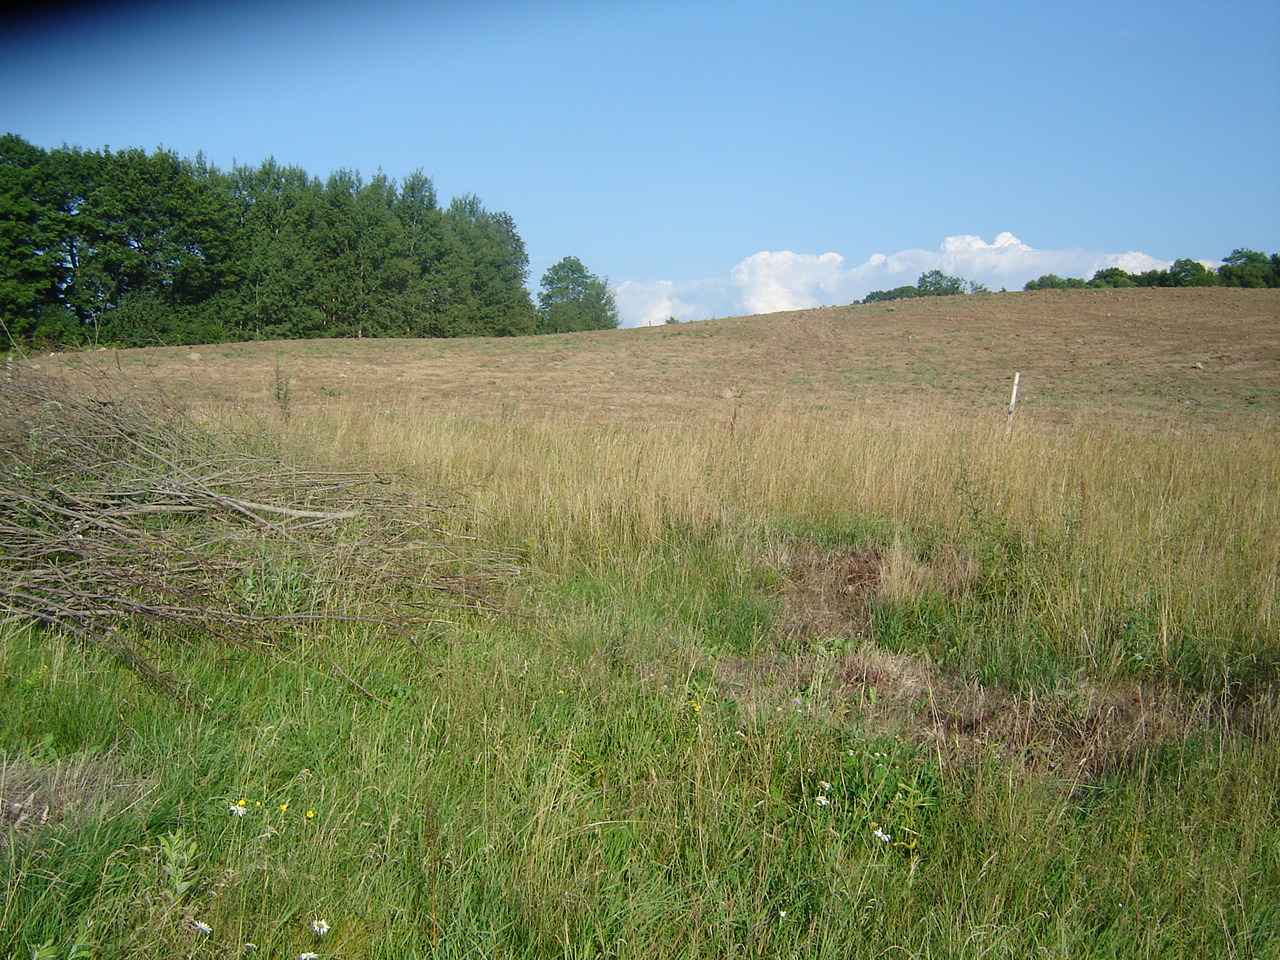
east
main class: Shrubland
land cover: Shrubland with sparse tree cover
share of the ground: 25 - 50 %
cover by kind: herbaceous plants 45 %, shrubs 30 %, unconsolidated bare surface 20 %, broadleaved forest trees 5 %
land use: Forestry
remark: Clear cut
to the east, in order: Shrubland with sparse tree cover; Spontaneously vegetated surfaces; Fences; Spontaneously vegetated surfaces; Broadleaved woodland; Grassland without tree/shrub cover; Paved roads, cycling and walking lanes; Grass margins; Lines of trees; Electric lines; Grassland without tree/shrub cover
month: August
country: LT
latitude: 55.1140
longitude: 25.3124
